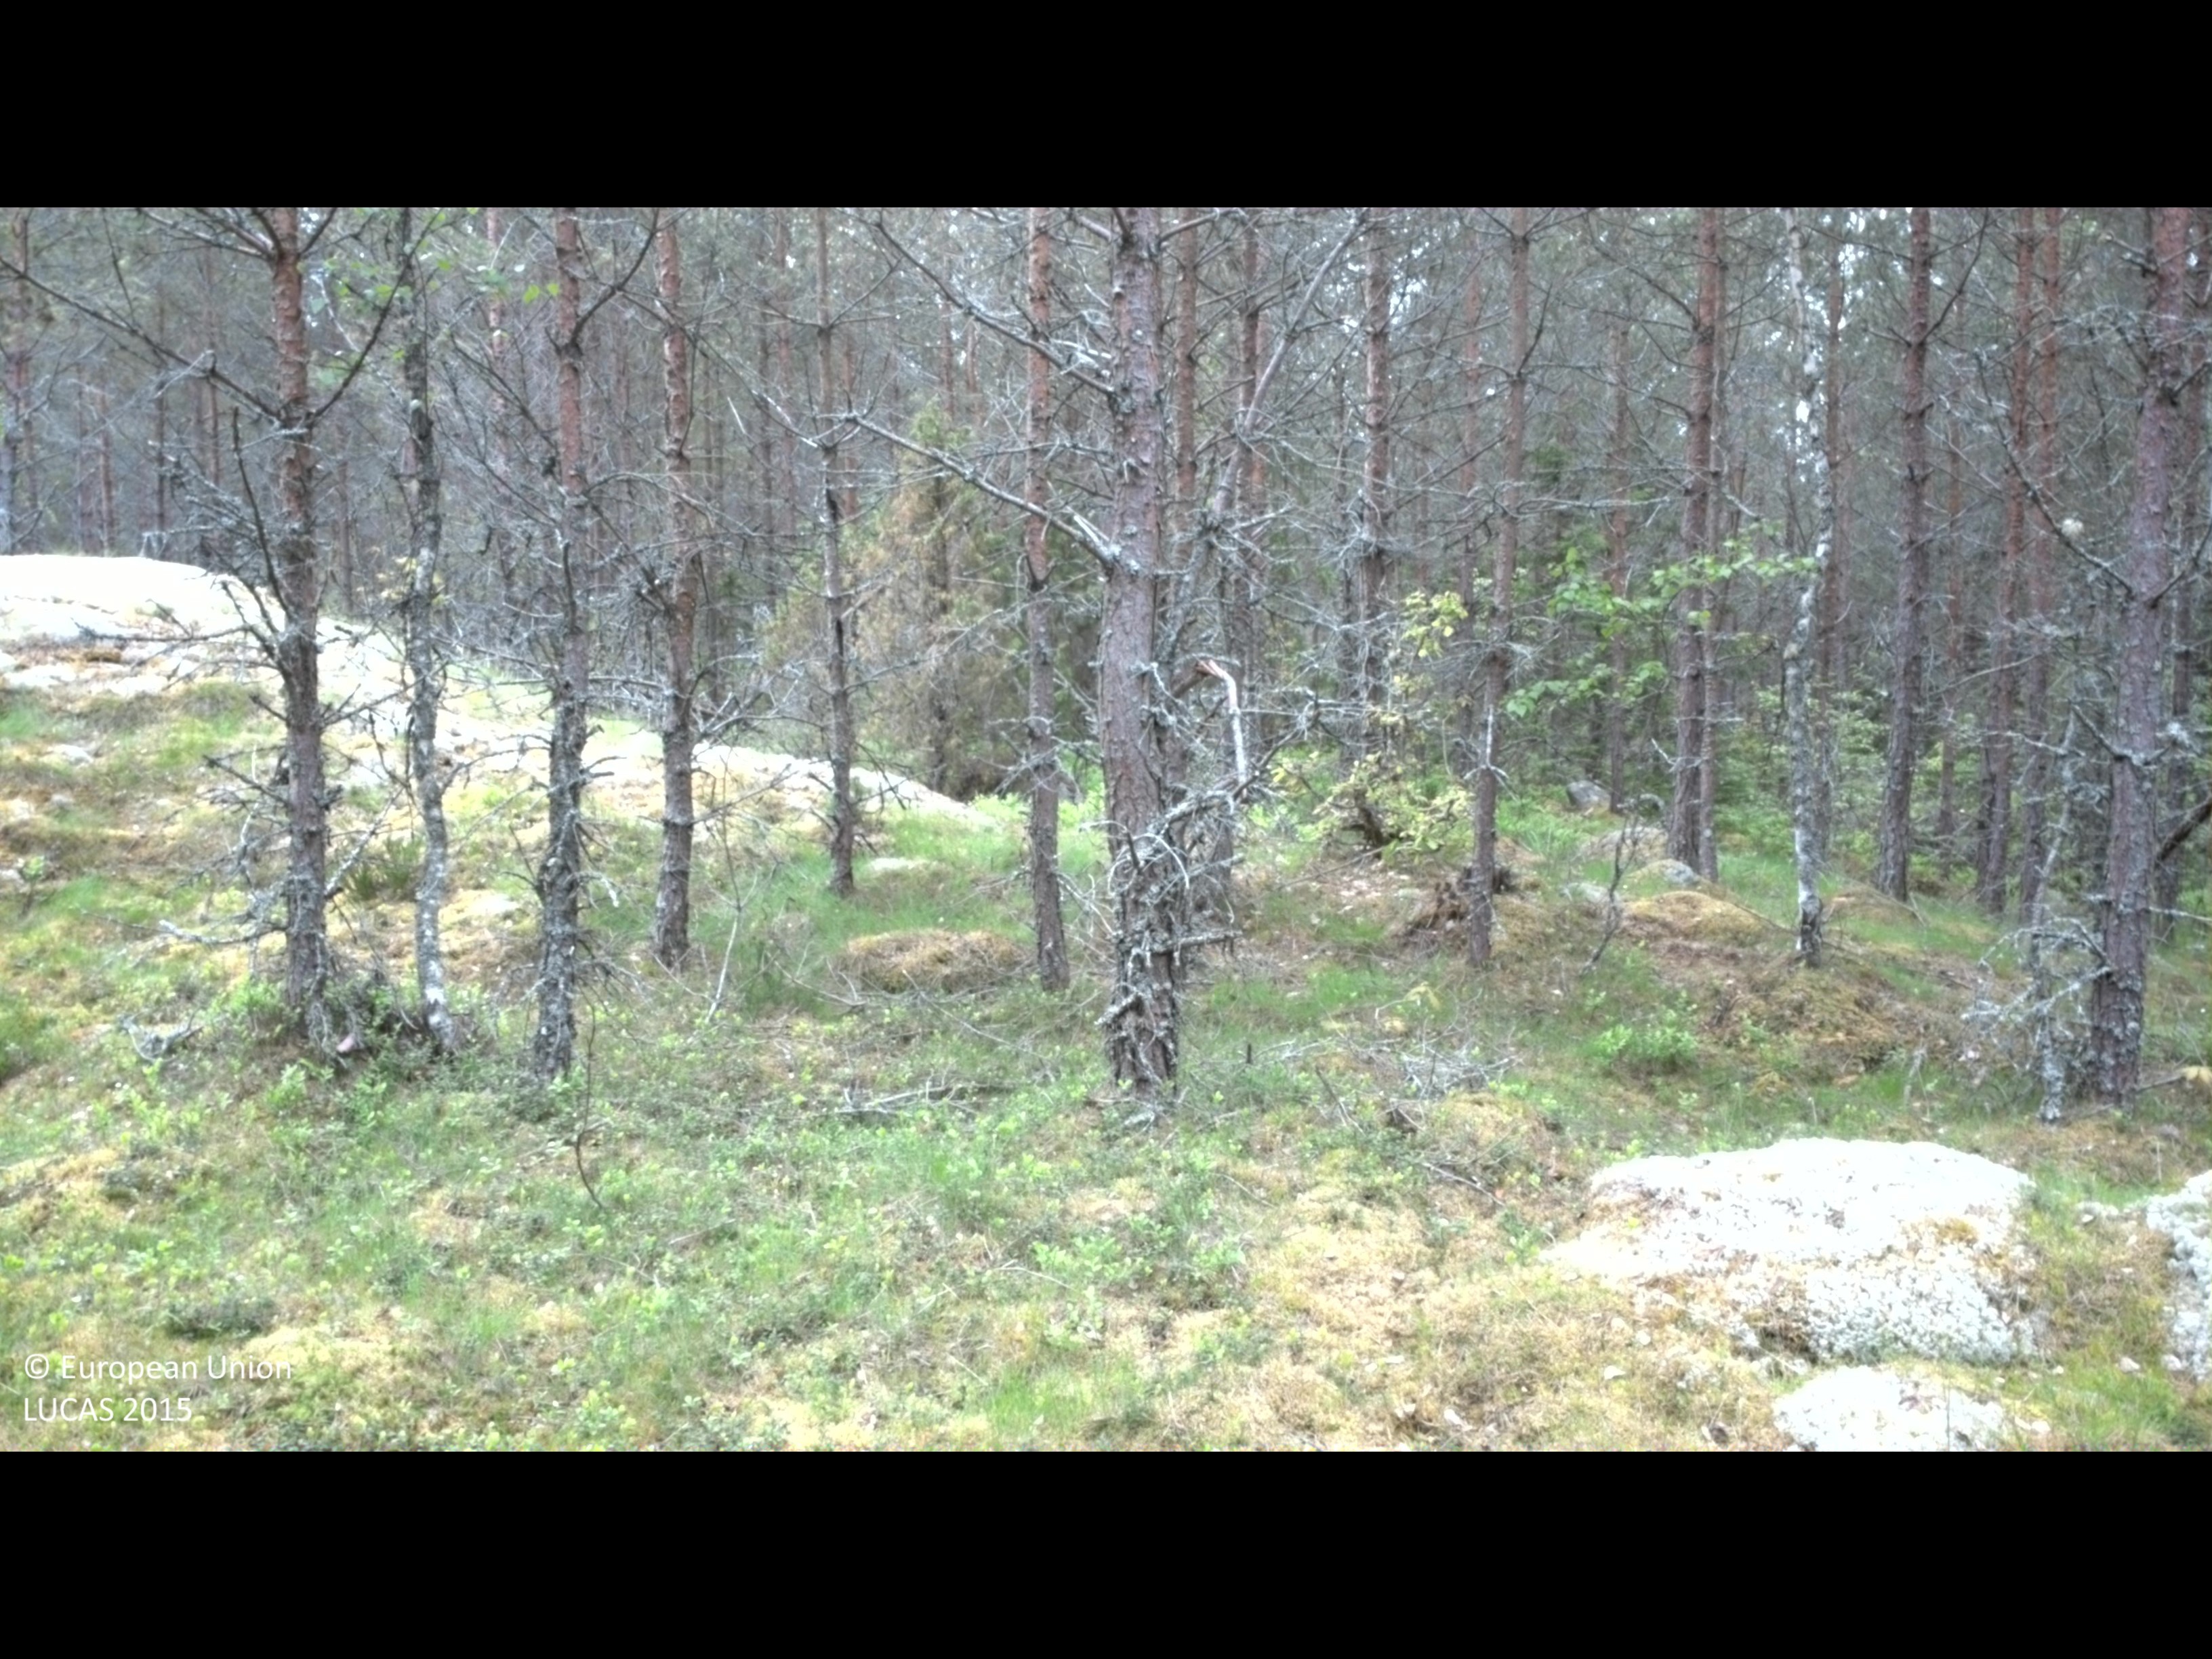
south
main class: Woodland
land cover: Pine dominated coniferous woodland
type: boreal forest
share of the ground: 25 - 50 %
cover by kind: coniferous forest trees 45 %, shrubs 30 %, lichens and mosses 20 %, broadleaved forest trees 5 %
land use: Forestry
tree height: > 5 m
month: June
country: SE
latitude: 57.6770
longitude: 16.2526
